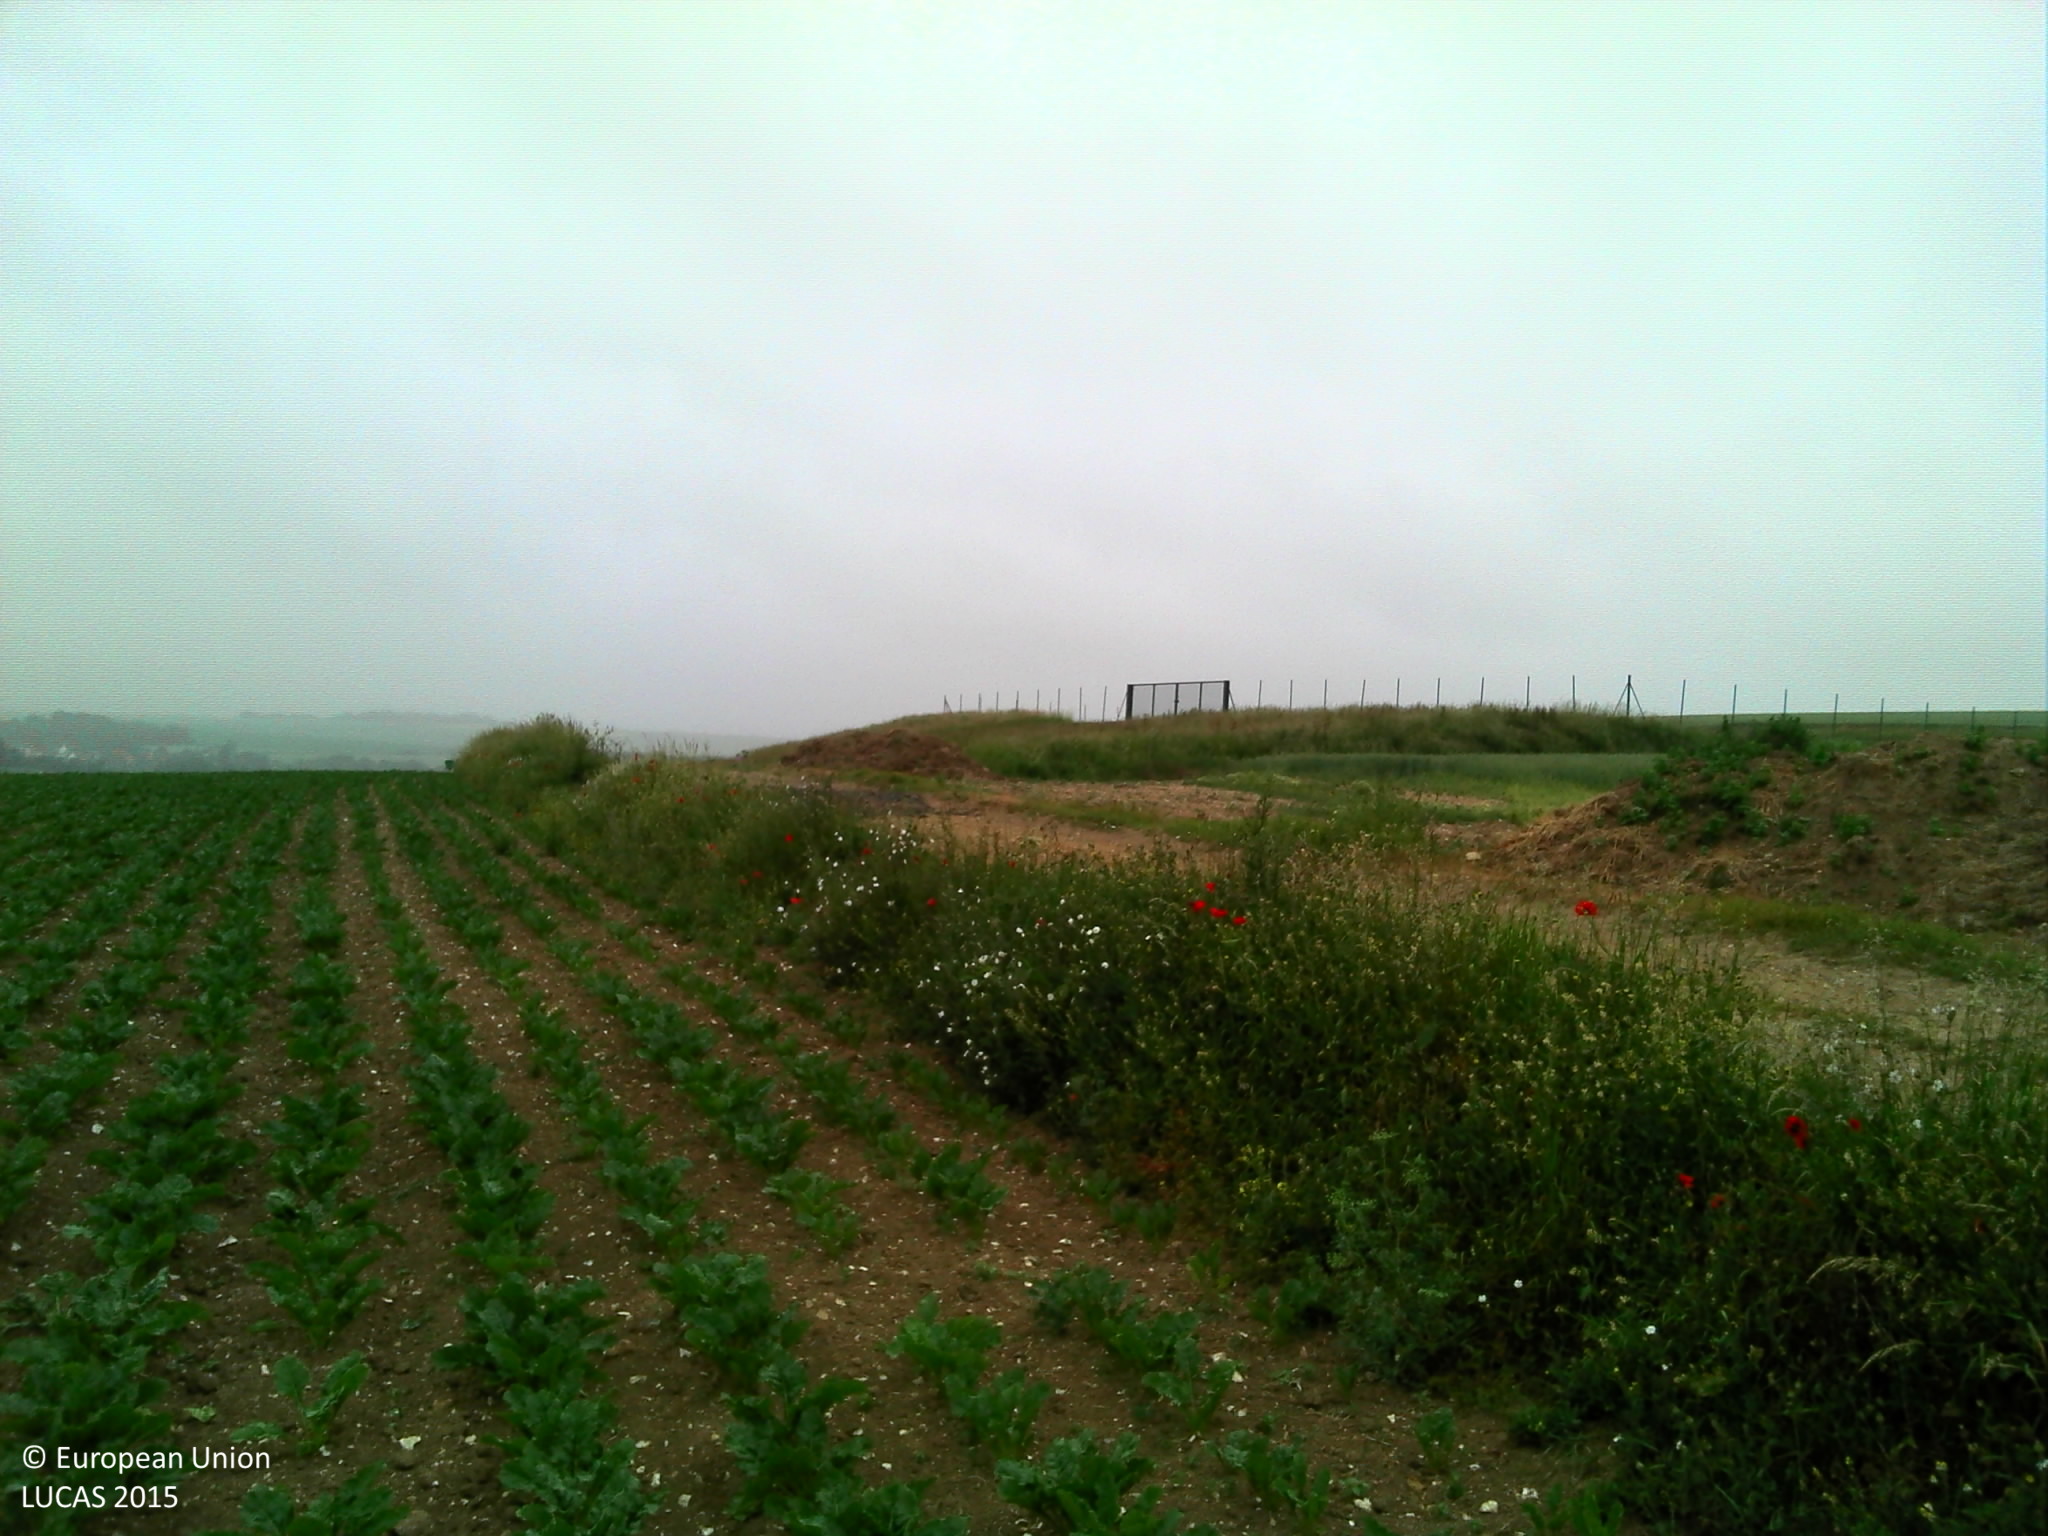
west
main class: Cropland
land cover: Sugar beet
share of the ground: 50 - 75 %
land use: Agriculture (excluding fallow land and kitchen gardens)
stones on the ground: < 10 %
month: June
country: FR
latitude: 49.4635
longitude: 2.4404
